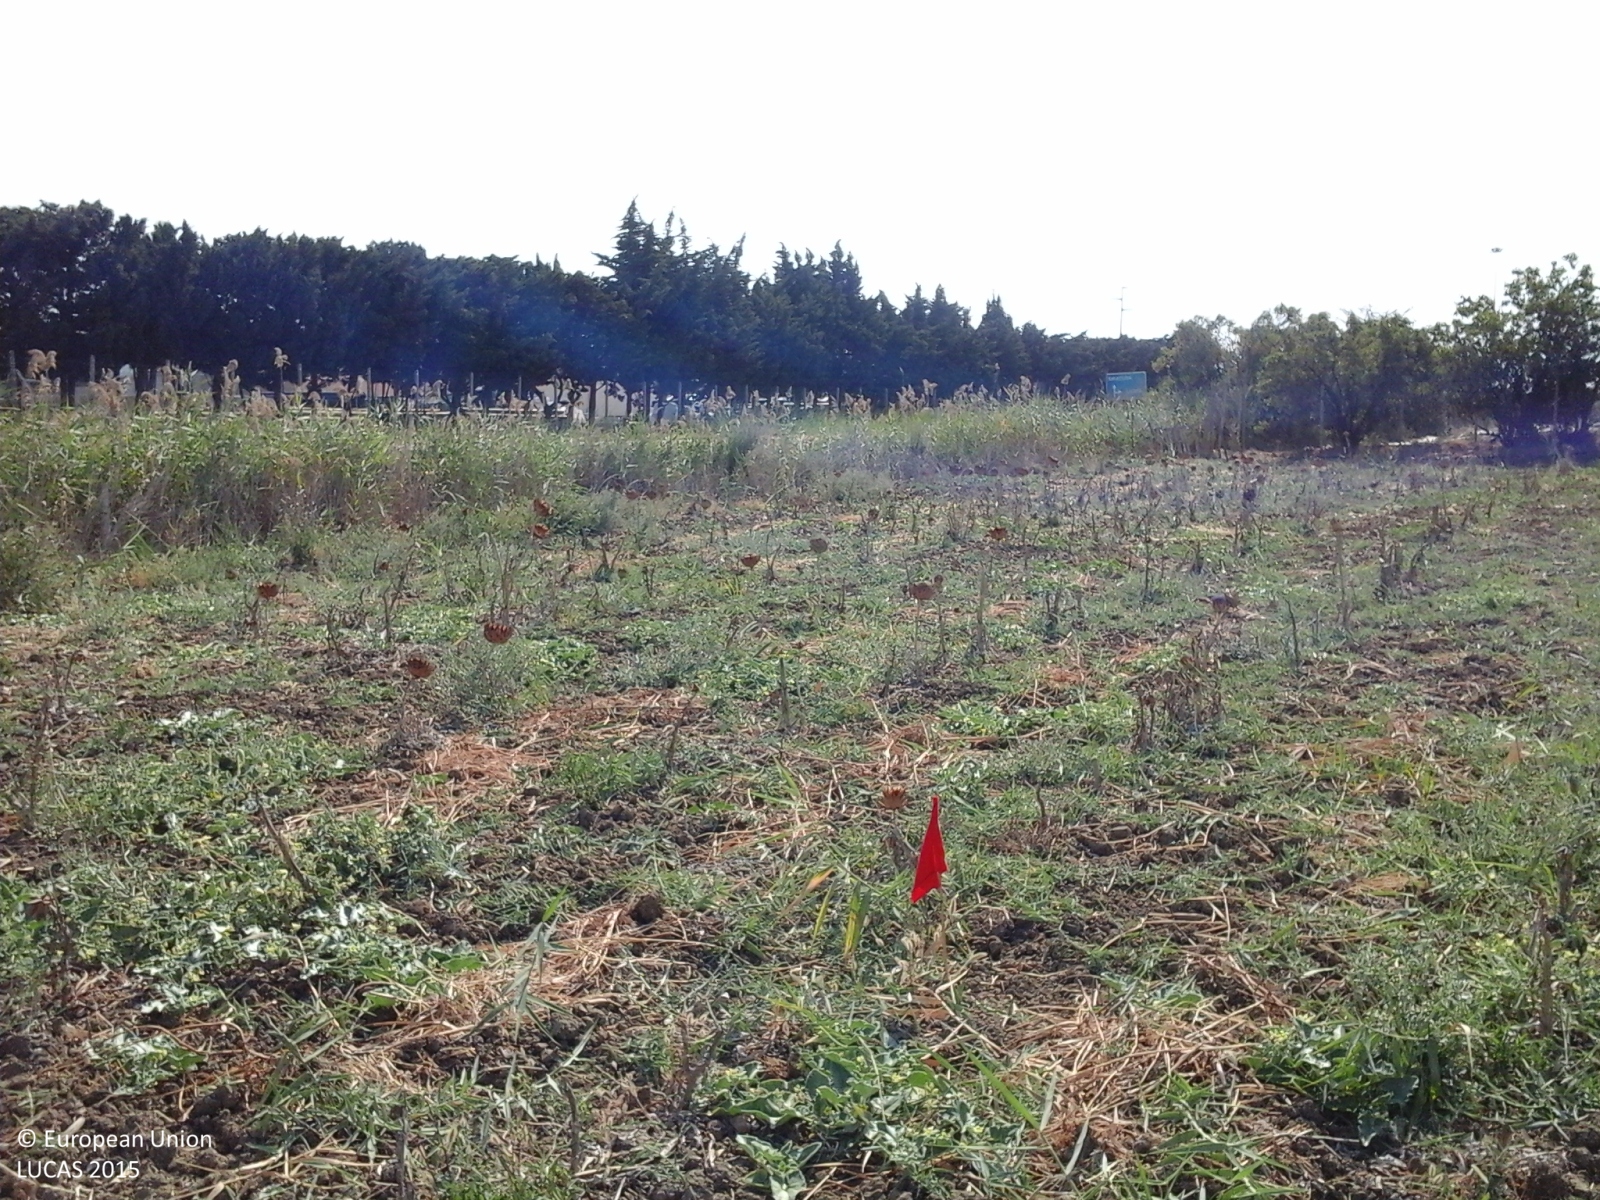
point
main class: Cropland
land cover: Other fresh vegetables
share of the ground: > 75 %
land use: Agriculture (excluding fallow land and kitchen gardens)
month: July
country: IT
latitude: 37.1223
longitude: 13.8971
